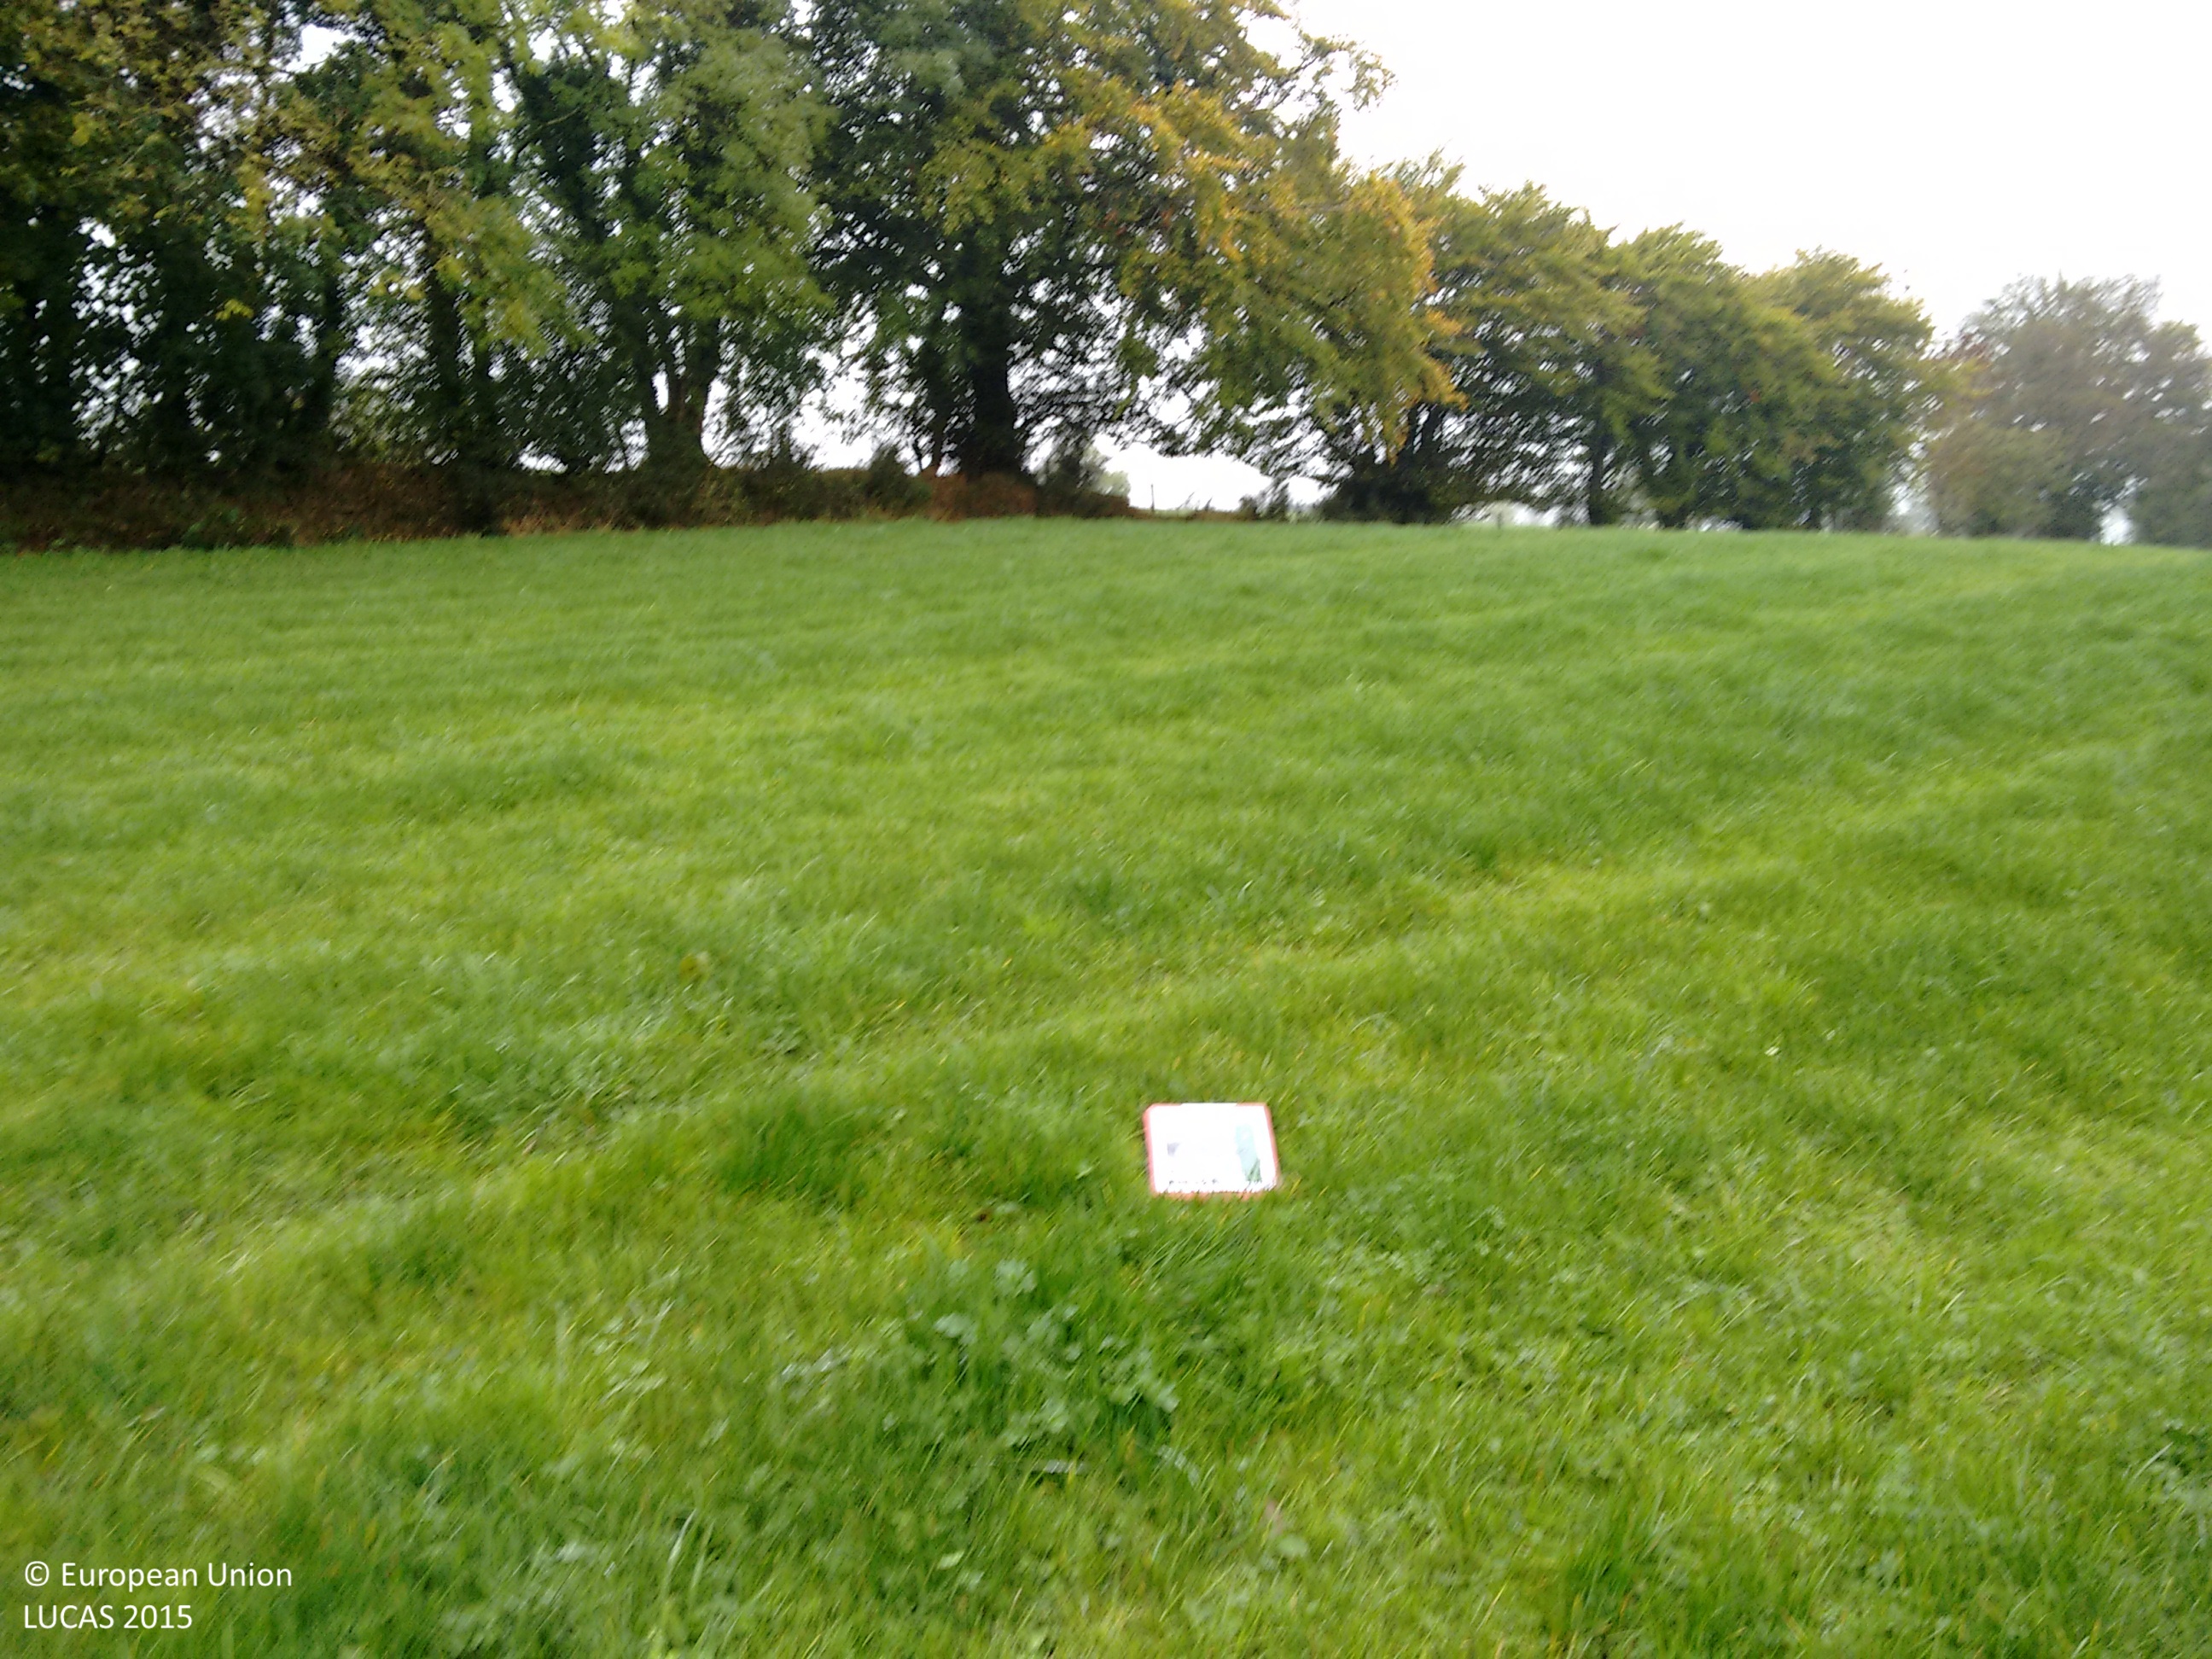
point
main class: Grassland
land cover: Grassland without tree/shrub cover
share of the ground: > 75 %
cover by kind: herbaceous plants 100 %
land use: Agriculture (excluding fallow land and kitchen gardens)
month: October
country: GB
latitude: 54.5568
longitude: -7.4251
